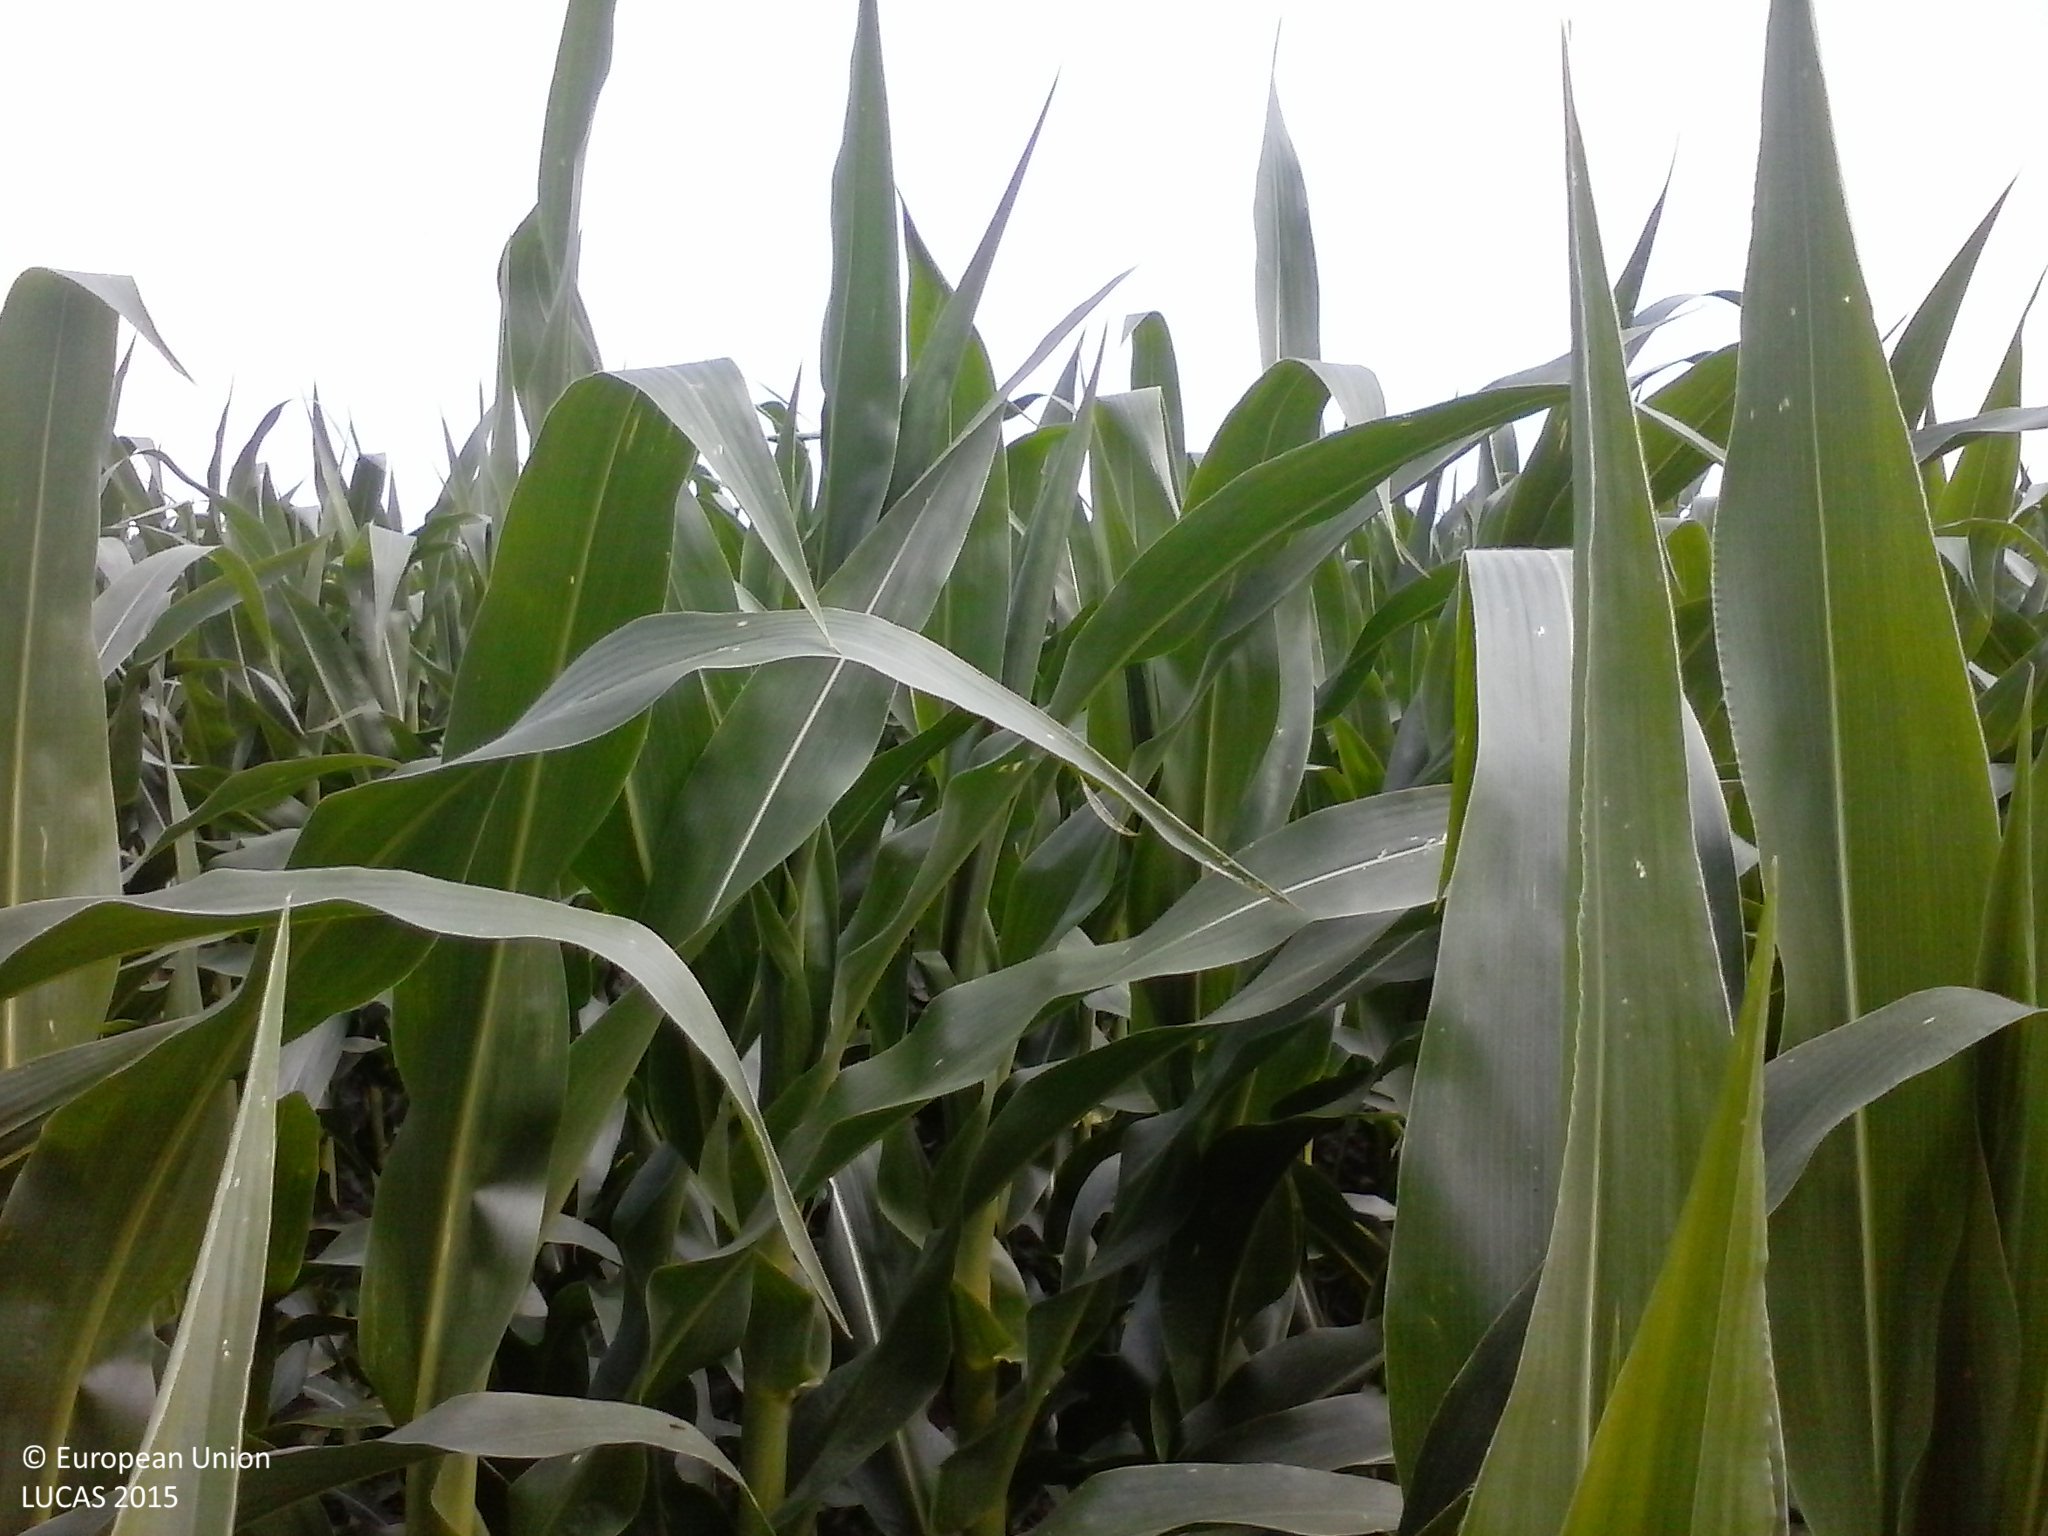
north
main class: Cropland
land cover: Maize
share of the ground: > 75 %
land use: Agriculture (excluding fallow land and kitchen gardens)
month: June
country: HU
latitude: 46.2027
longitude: 19.4636
